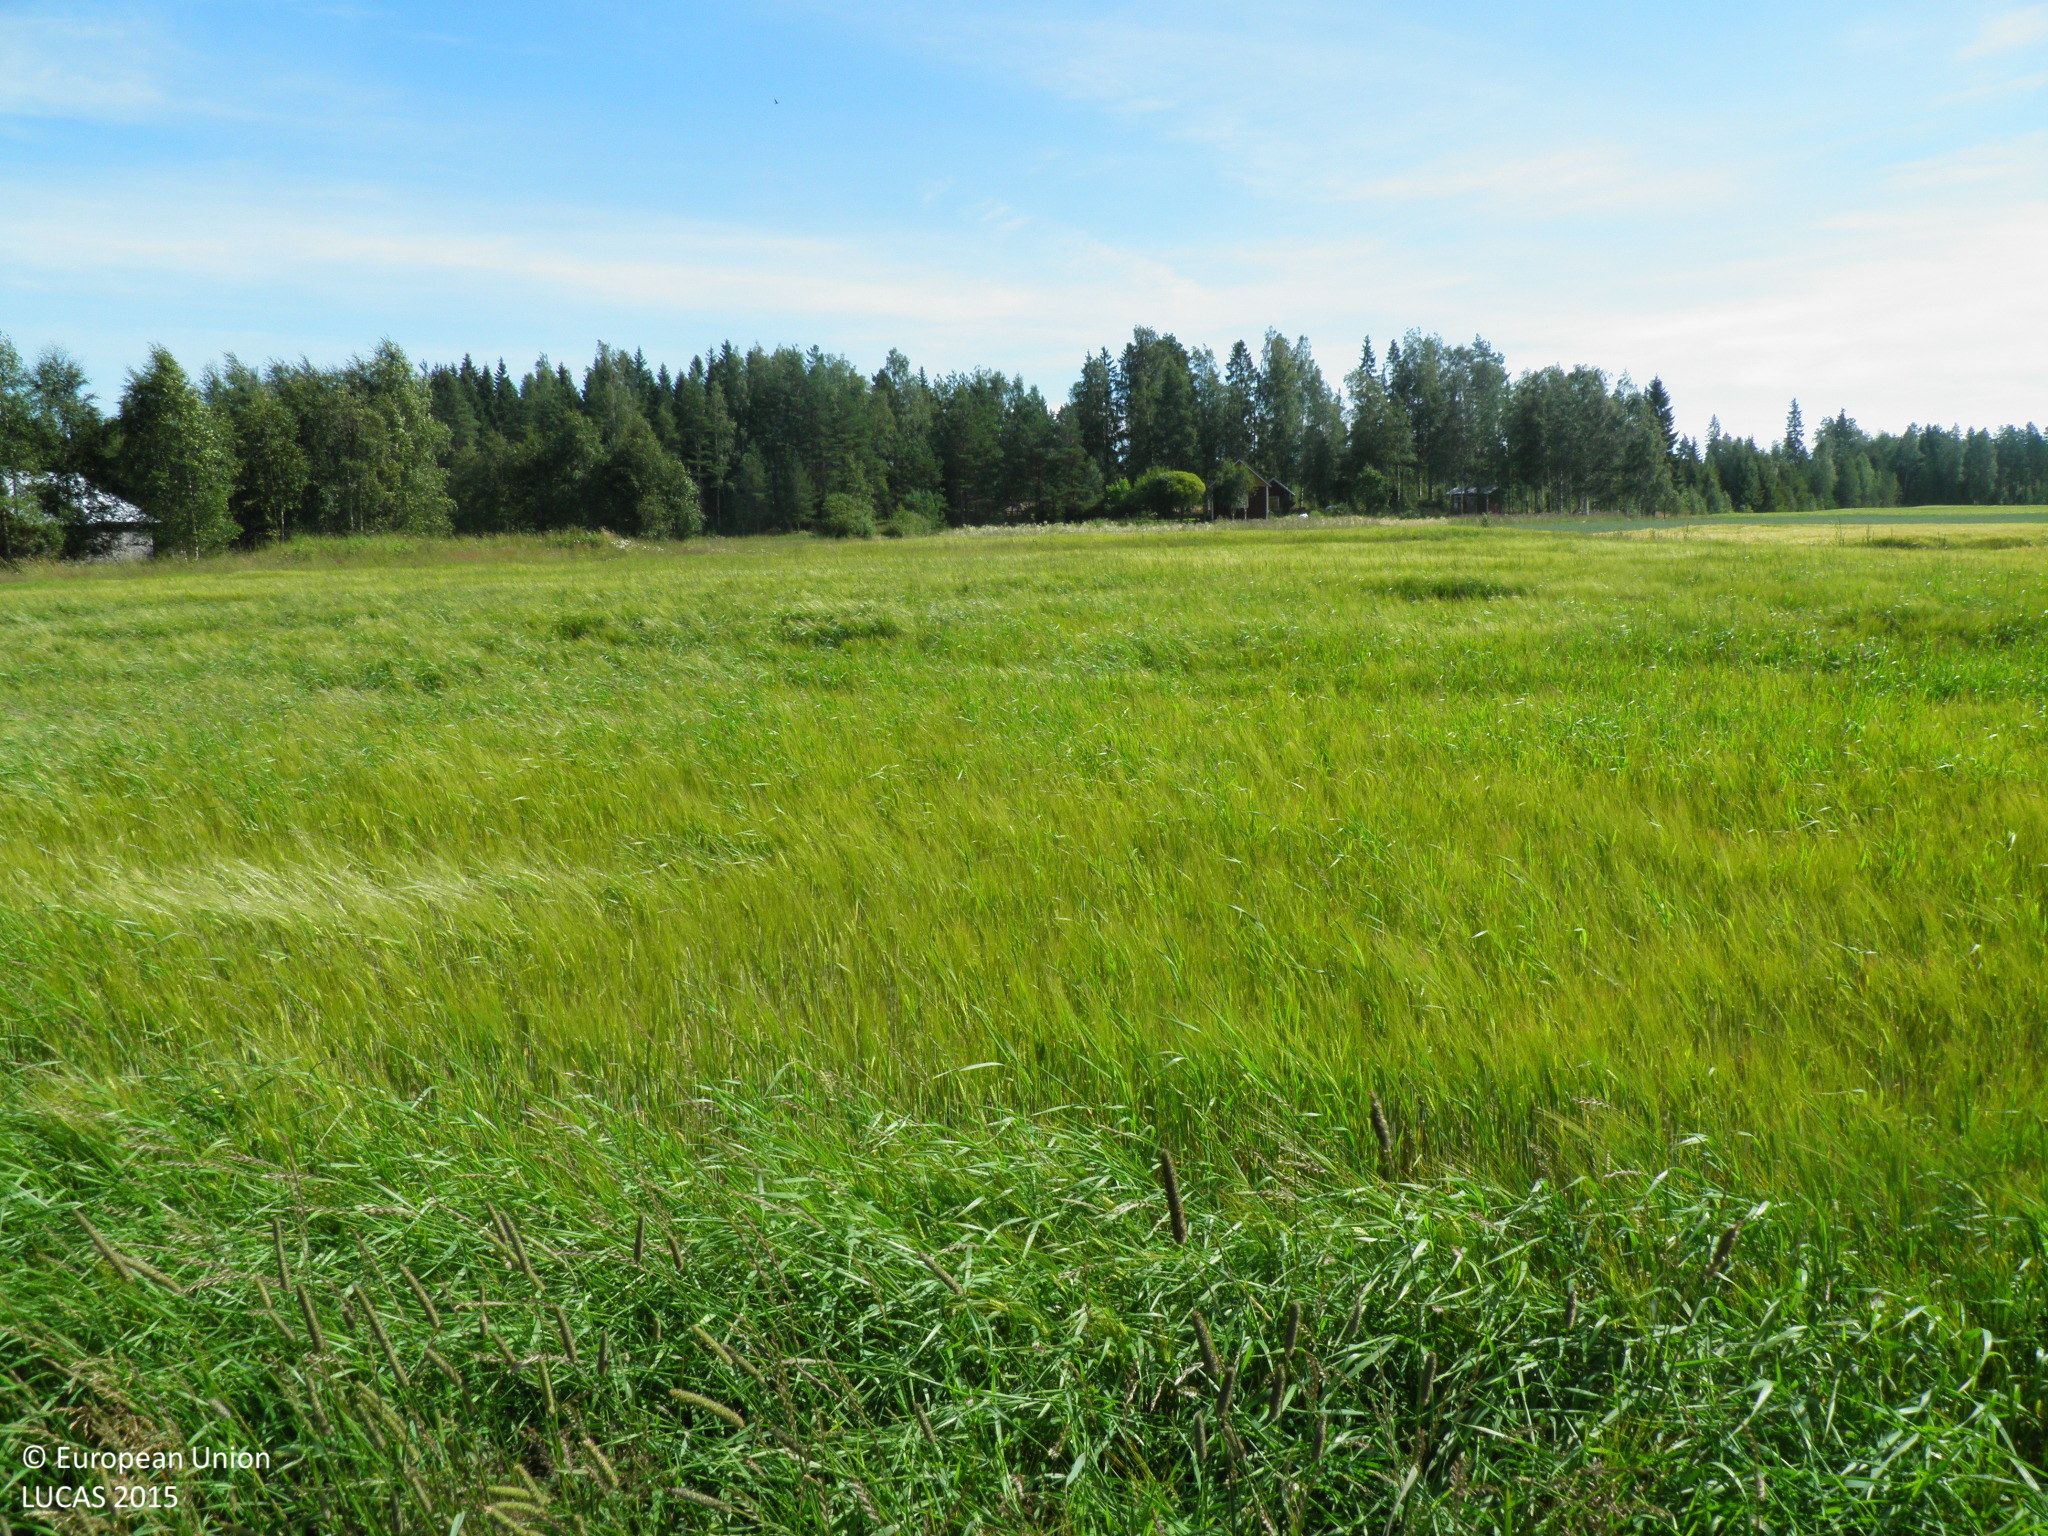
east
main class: Cropland
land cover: Barley
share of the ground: > 75 %
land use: Agriculture (excluding fallow land and kitchen gardens)
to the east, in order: Barley; Grass margins; Ditches and canals; Grass margins; Barley; Grassland without tree/shrub cover; Broadleaved woodland; Grassland without tree/shrub cover; Abandoned hedges; Ditches and canals; Barley; Grass margins; Ditches and canals; Grass margins; Barley; Temporary grasslands; Sugar beet; Mixed cereals for fodder
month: August
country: FI
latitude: 61.0185
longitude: 22.8193
